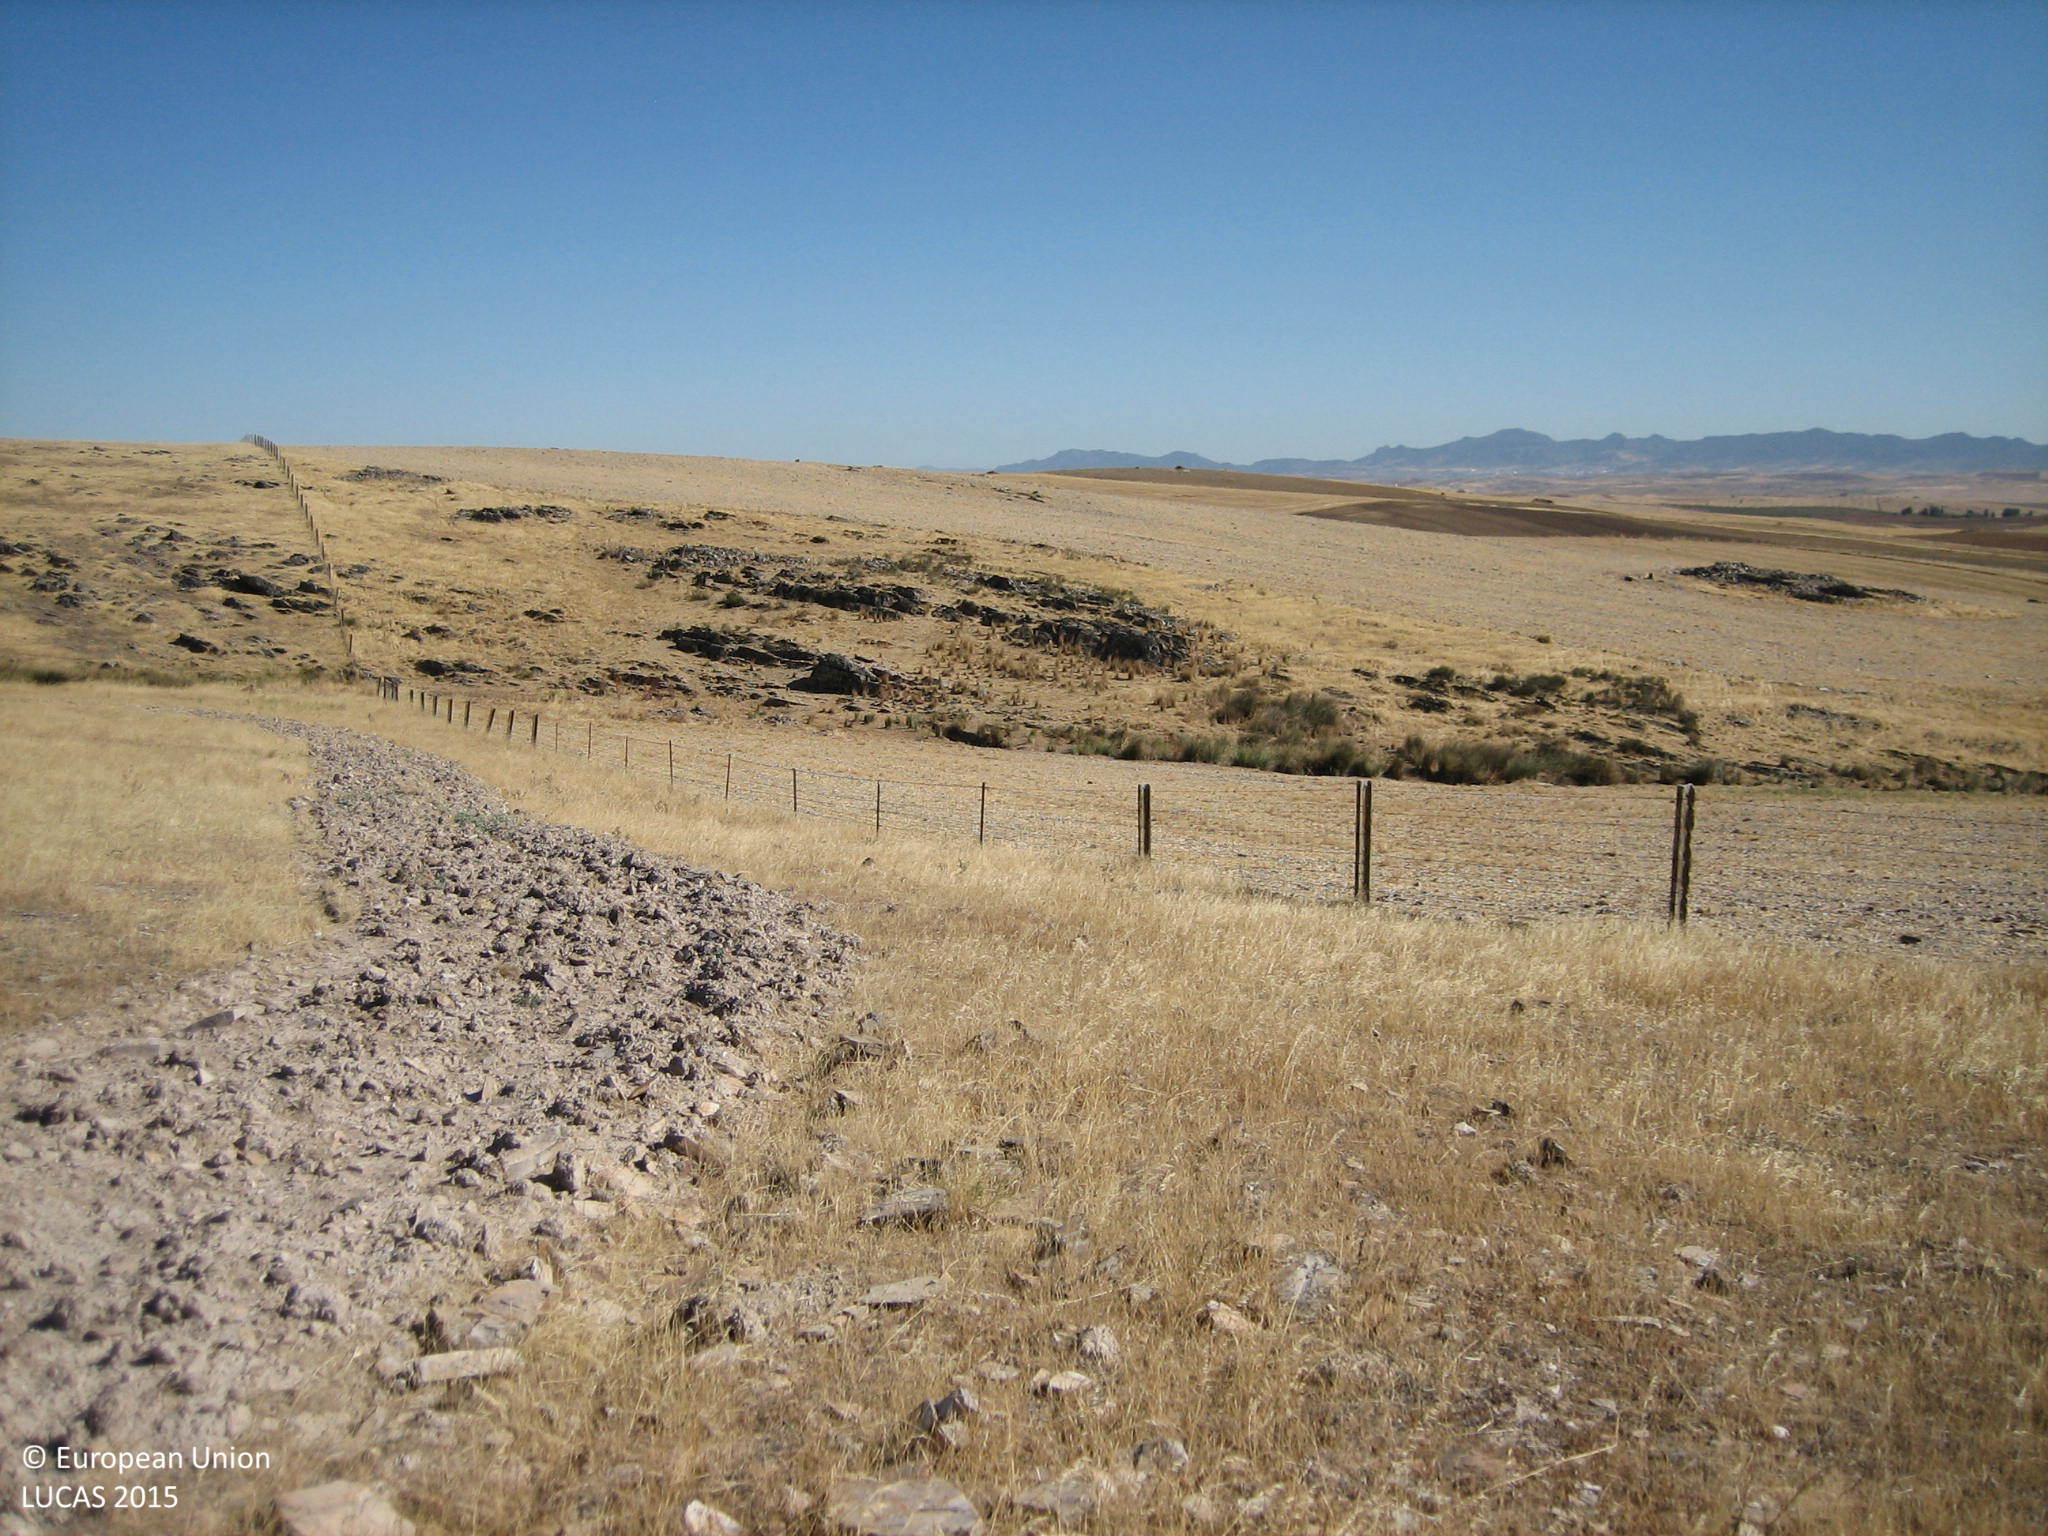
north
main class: Grassland
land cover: Spontaneously vegetated surfaces
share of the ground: > 75 %
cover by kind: herbaceous plants 100 %
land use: Fallow land
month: July
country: ES
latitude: 38.3710
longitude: -6.1256
